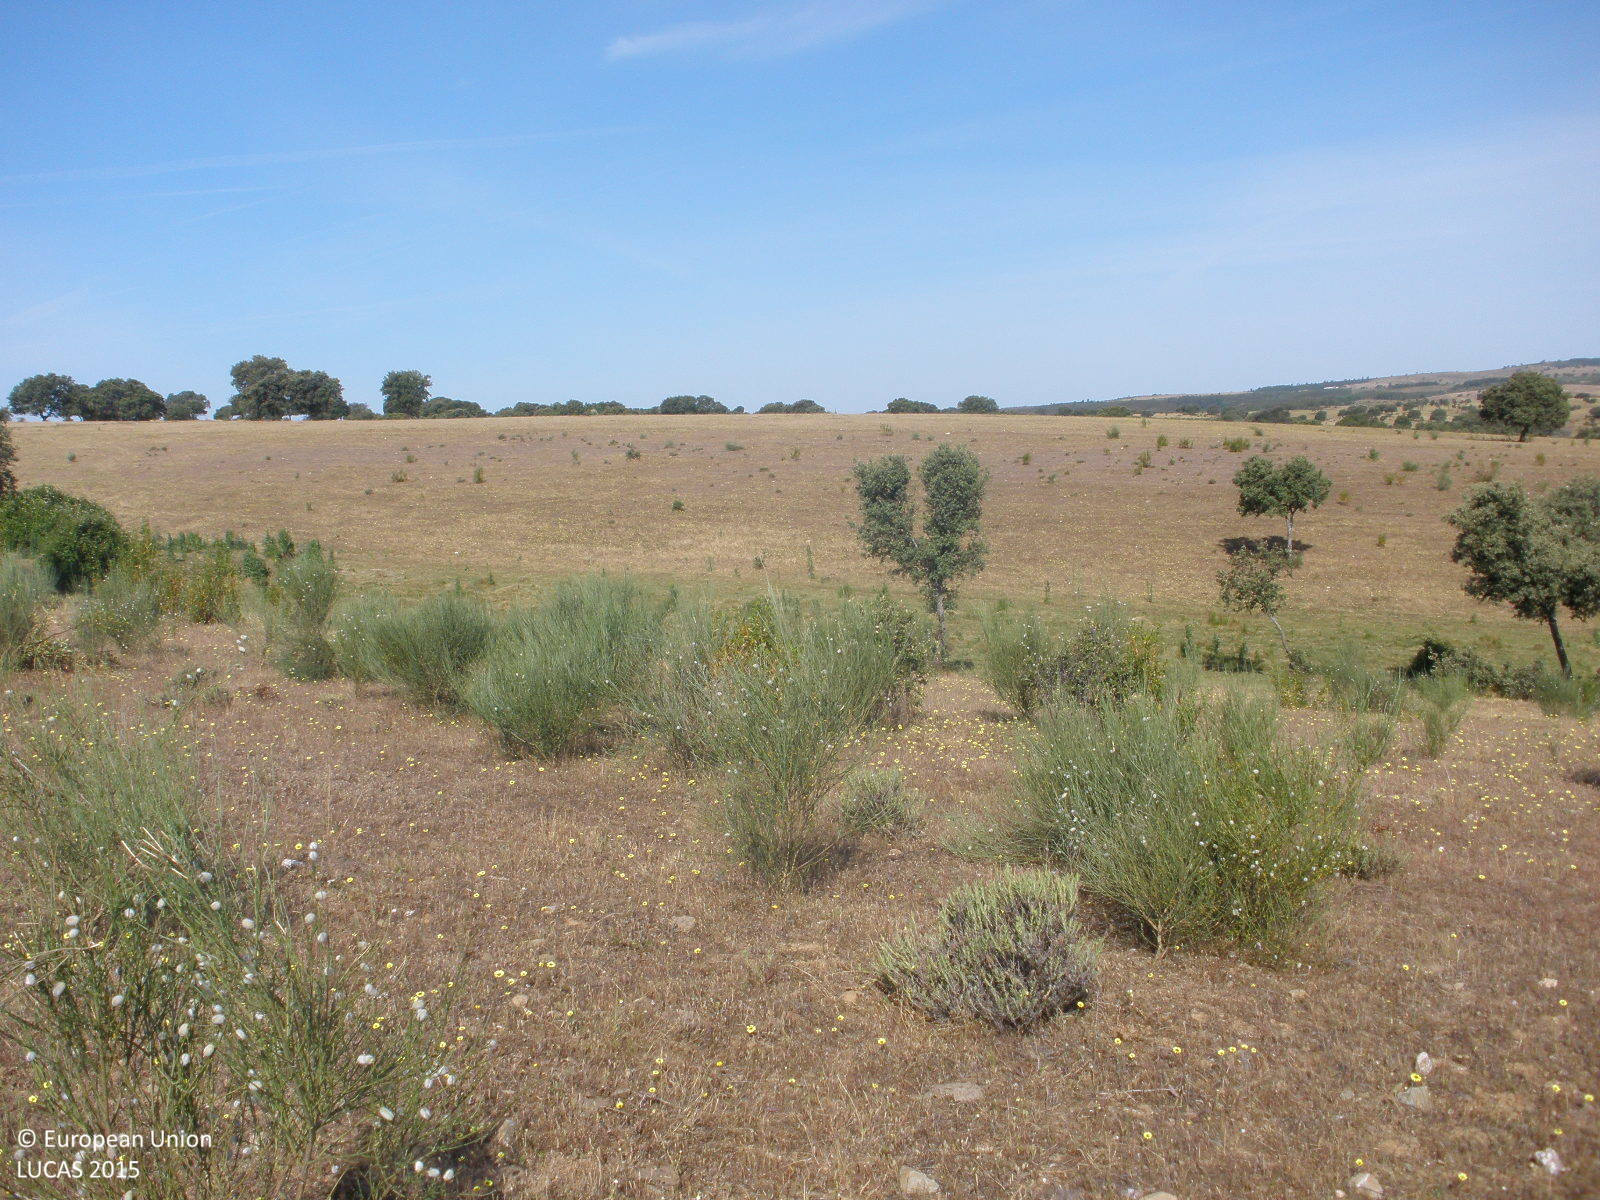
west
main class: Shrubland
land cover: Shrubland without tree cover
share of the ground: > 75 %
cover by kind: shrubs 50 %, herbaceous plants 35 %, consolidated bare surface 15 %
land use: Agriculture (excluding fallow land and kitchen gardens)
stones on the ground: 25 - 50 %
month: May
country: ES
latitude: 40.0694
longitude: -6.7474
